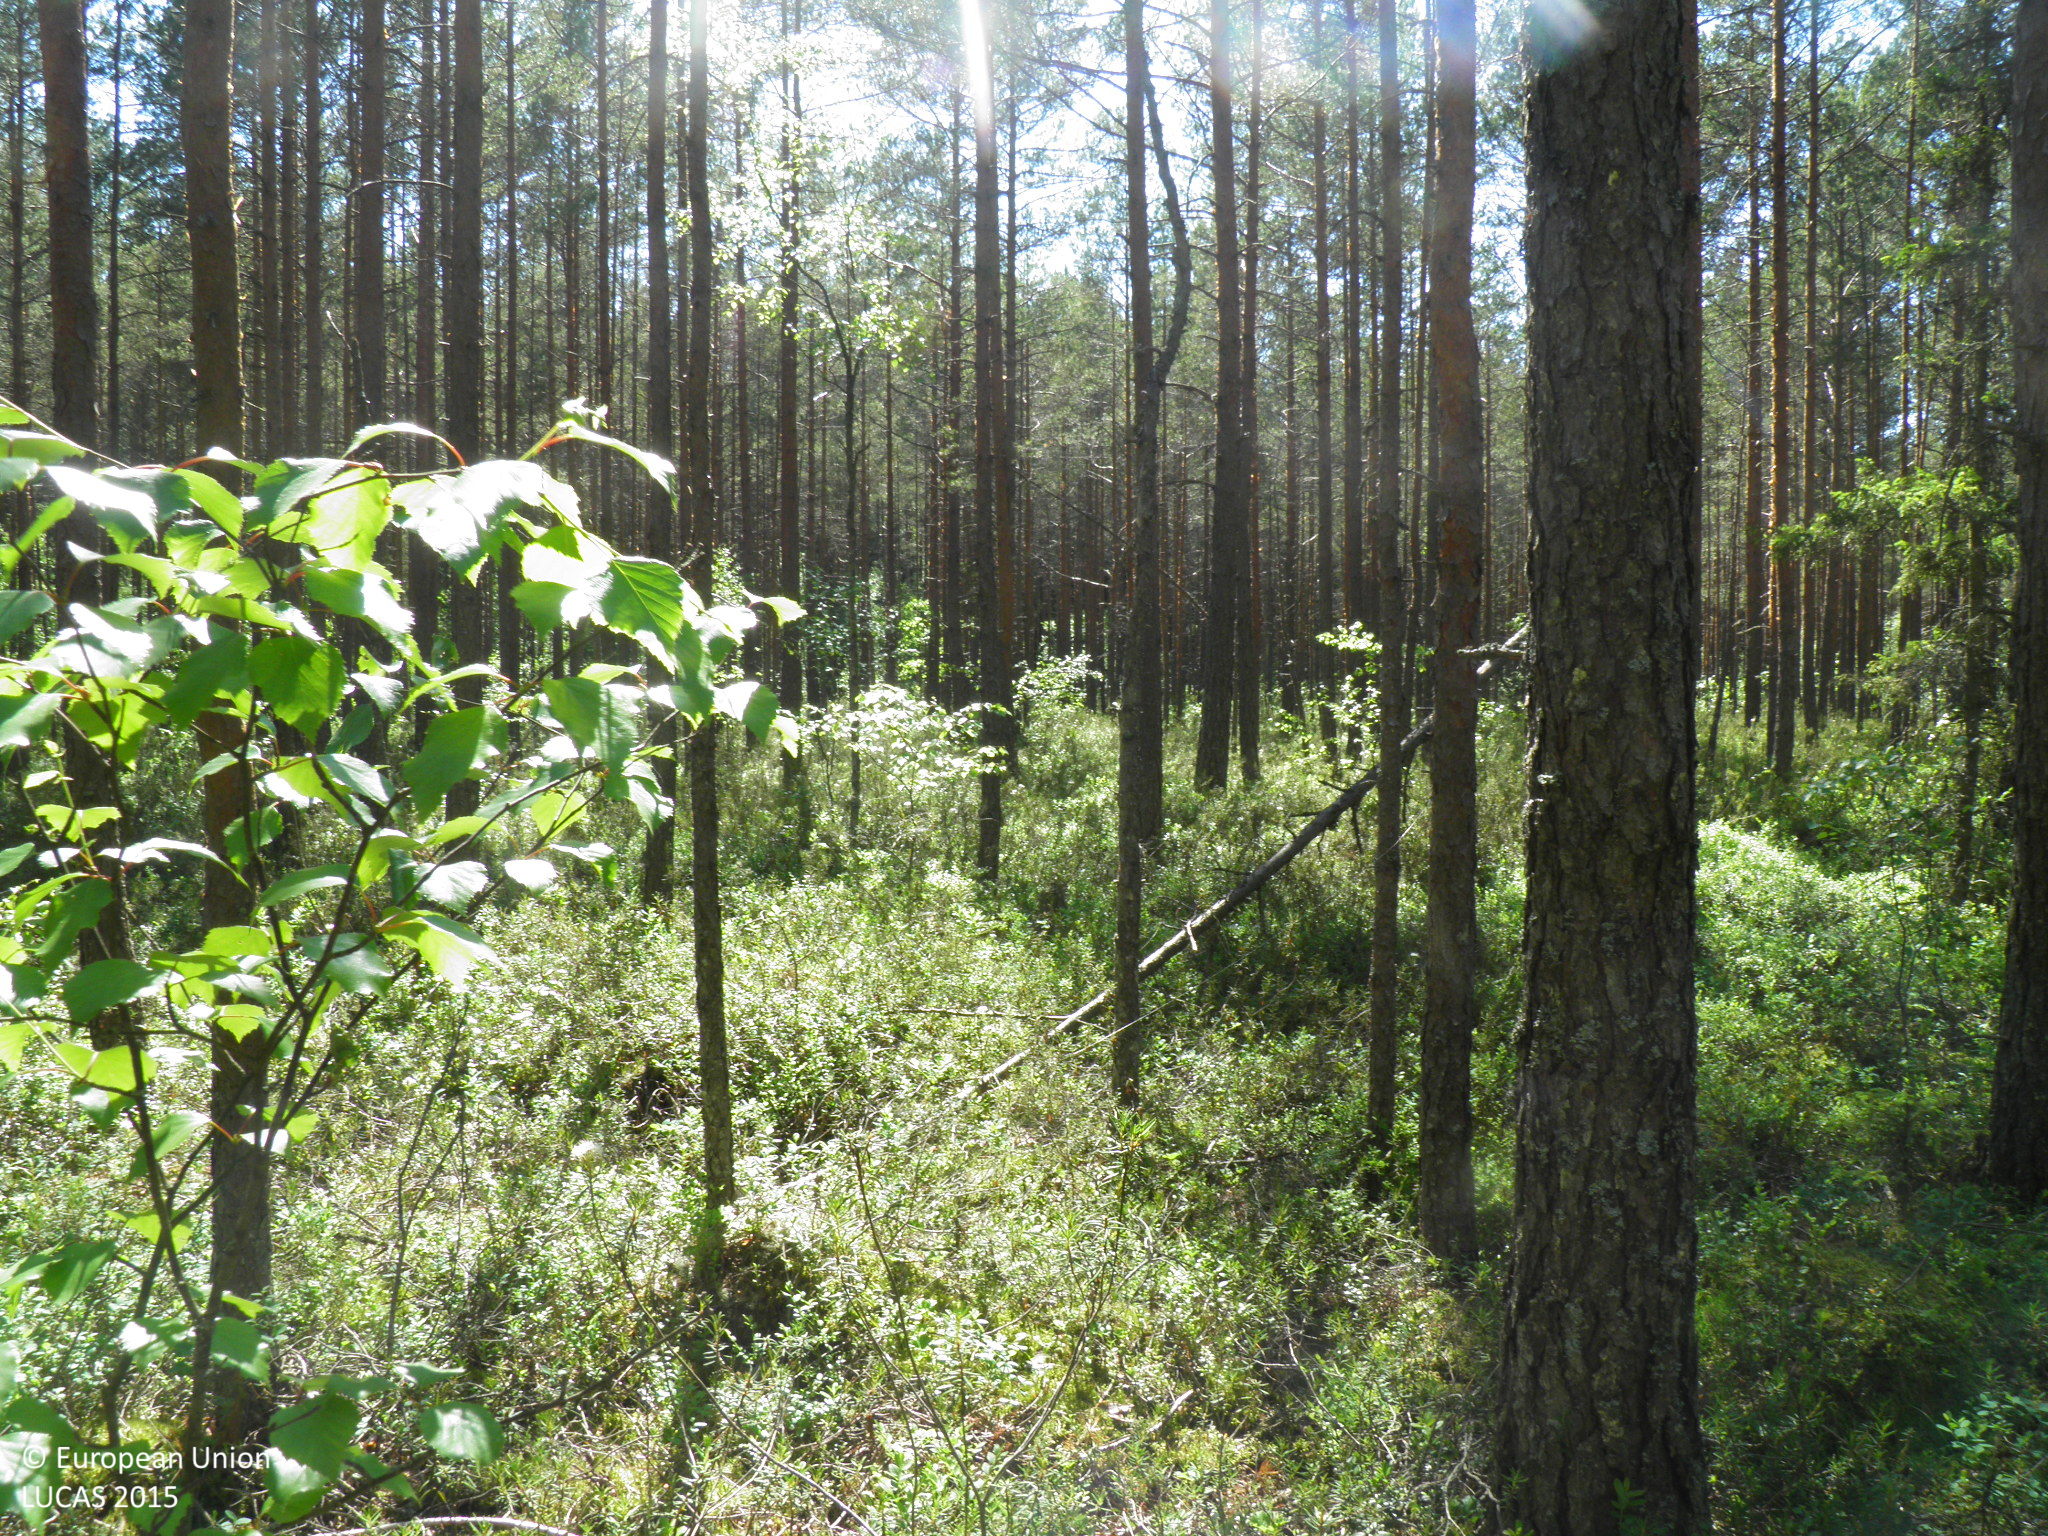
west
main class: Woodland
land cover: Pine dominated coniferous woodland
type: hemiboreal forest and nemoral coniferous forest and mixed broadleaved-coniferous forest
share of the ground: > 75 %
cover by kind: coniferous forest trees 75 %, shrubs 15 %, lichens and mosses 10 %
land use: Forestry
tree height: > 5 m
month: June
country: FI
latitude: 60.4726
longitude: 22.7898
